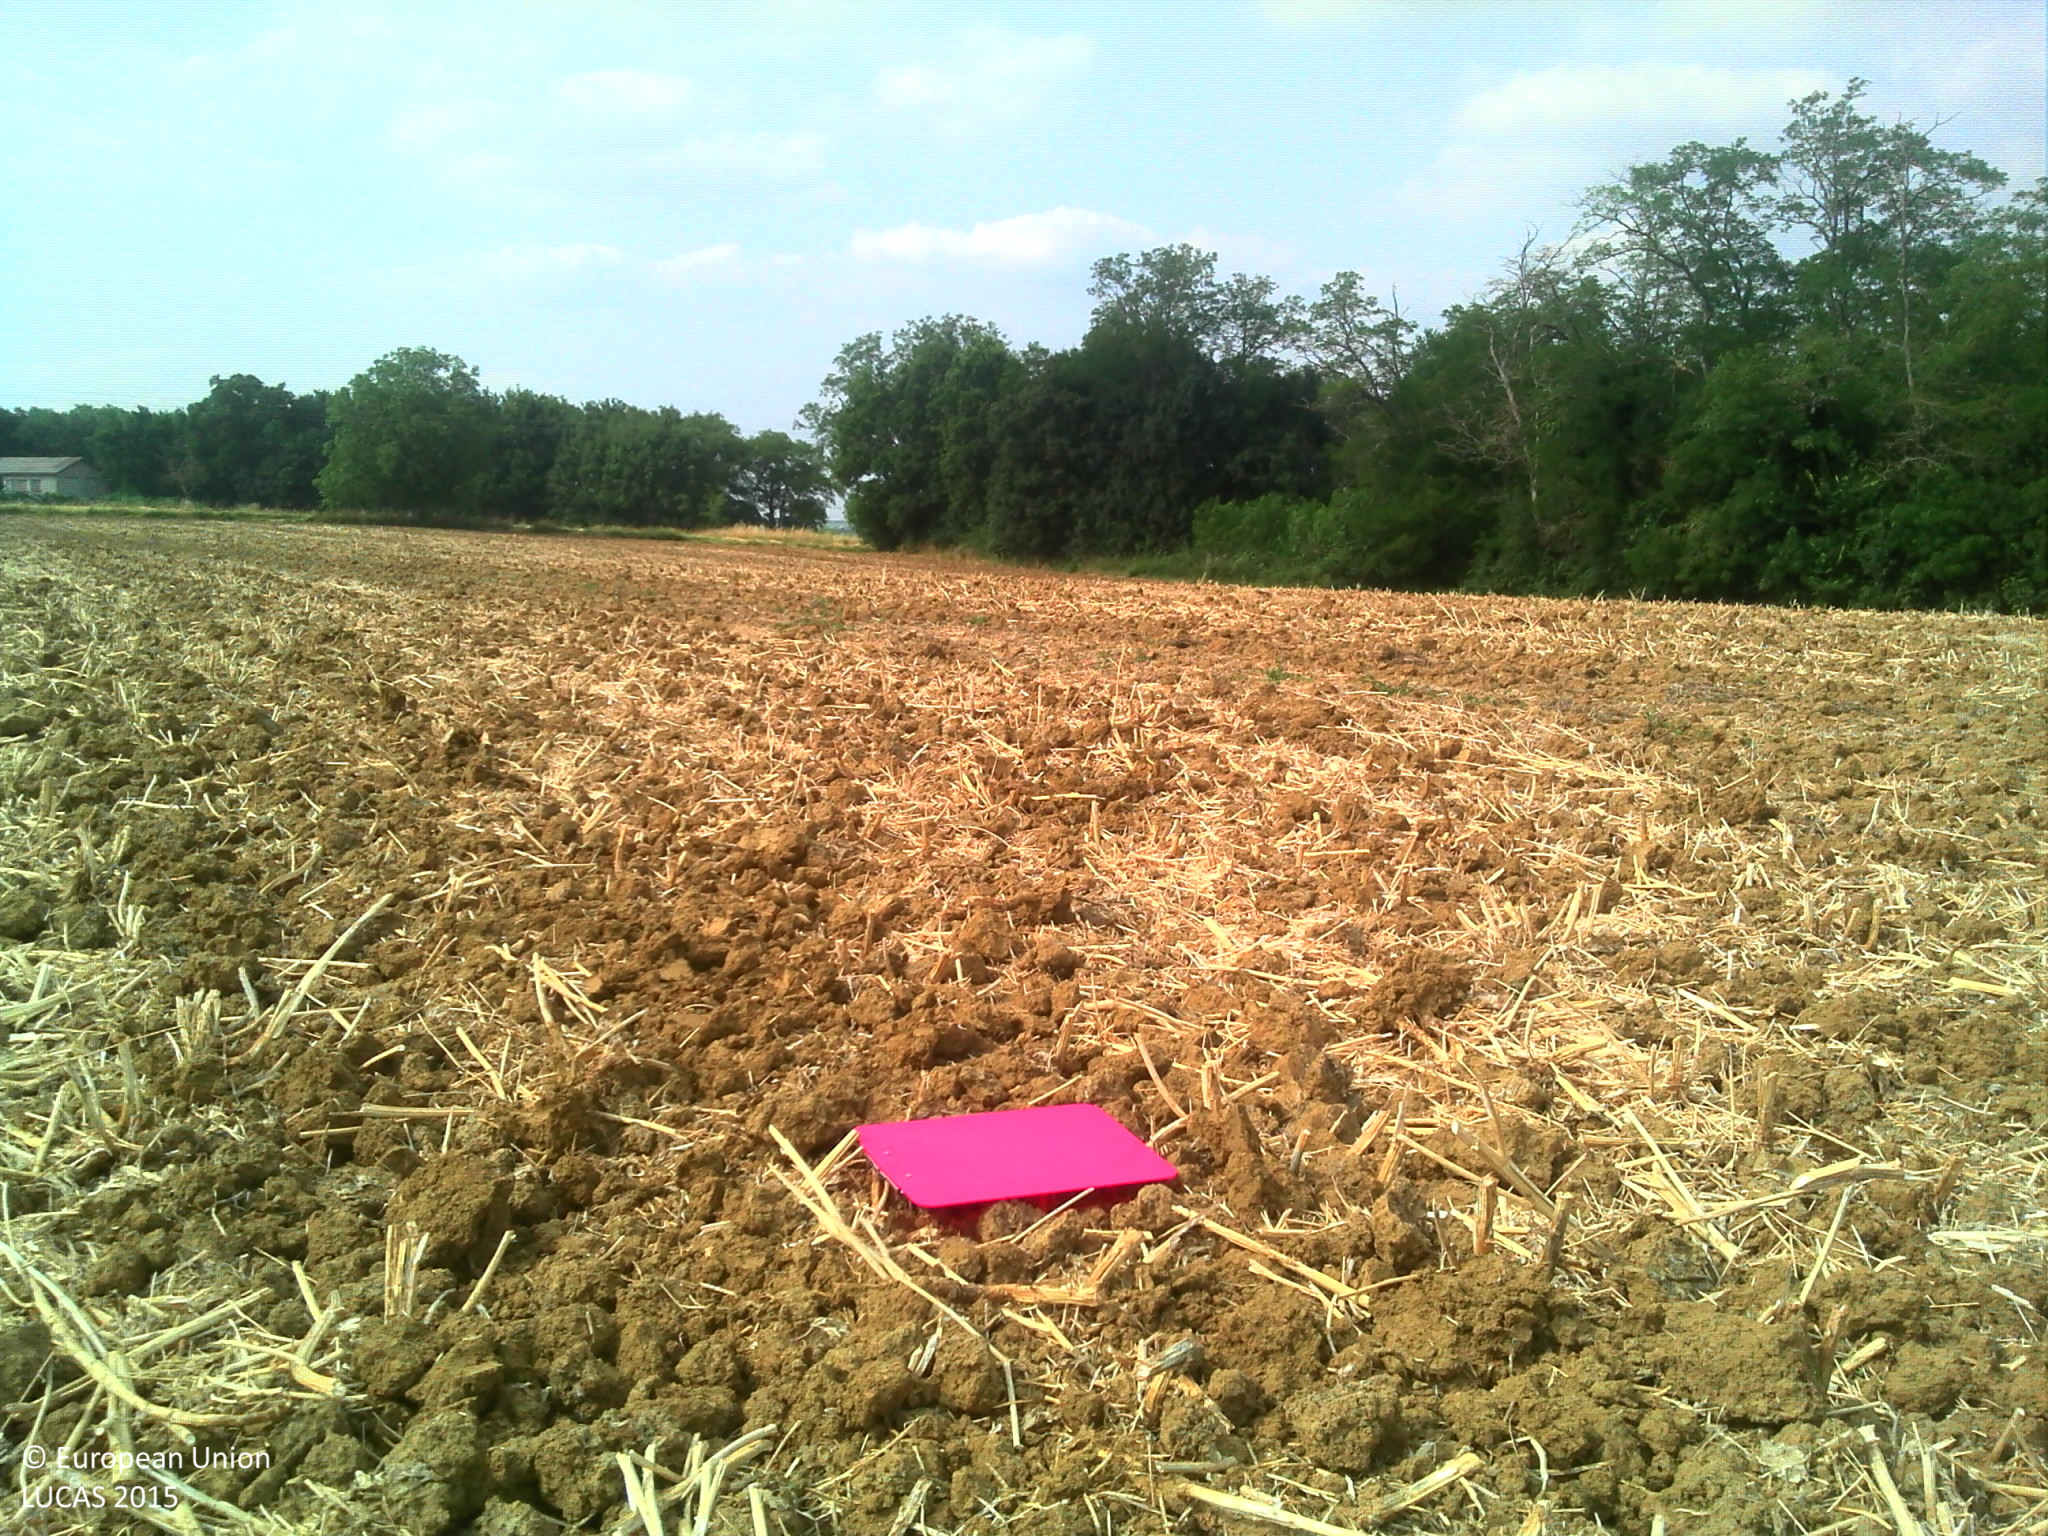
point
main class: Cropland
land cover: Rape and turnip rape
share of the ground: 10 - 25 %
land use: Agriculture (excluding fallow land and kitchen gardens)
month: July
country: FR
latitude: 44.2619
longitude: 0.9400
